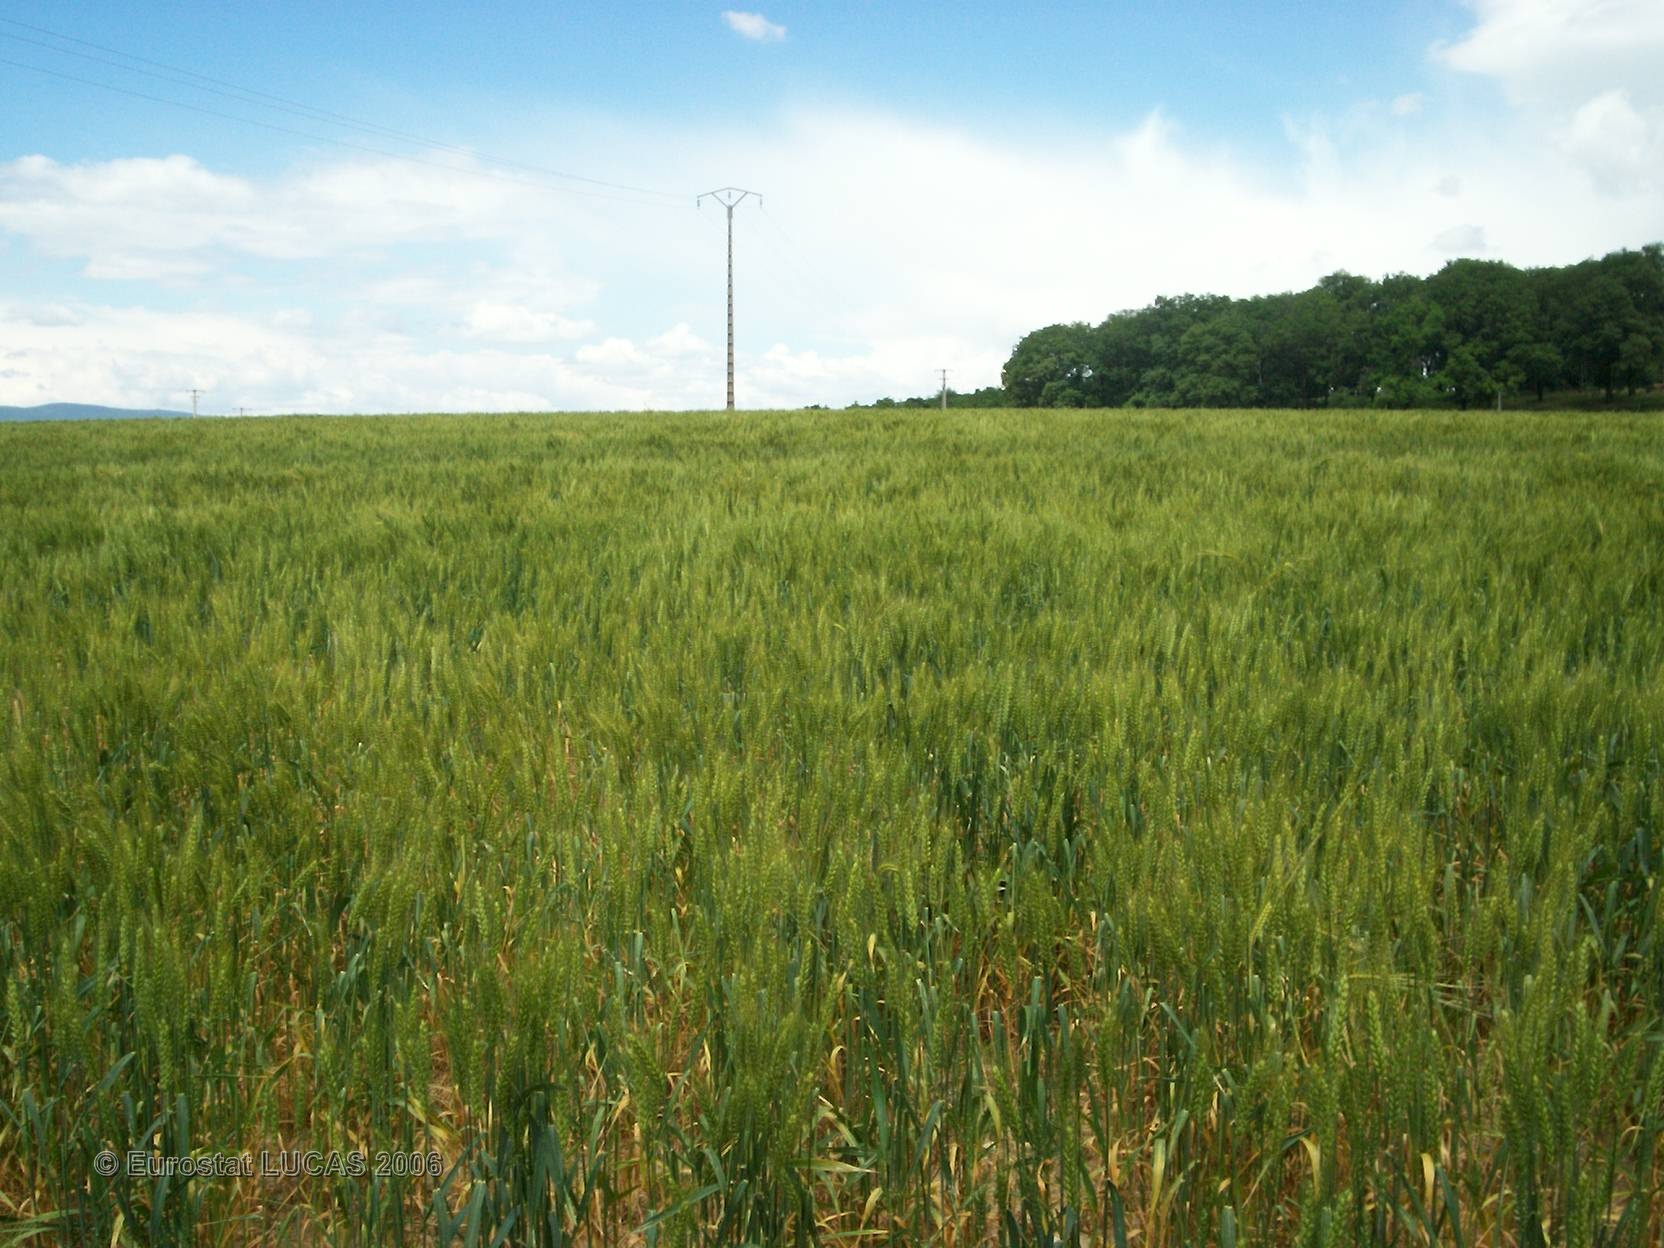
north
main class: Cropland
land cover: Durum wheat
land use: Agriculture (excluding fallow land and kitchen gardens)
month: May
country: FR
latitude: 44.5508
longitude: 4.9087
